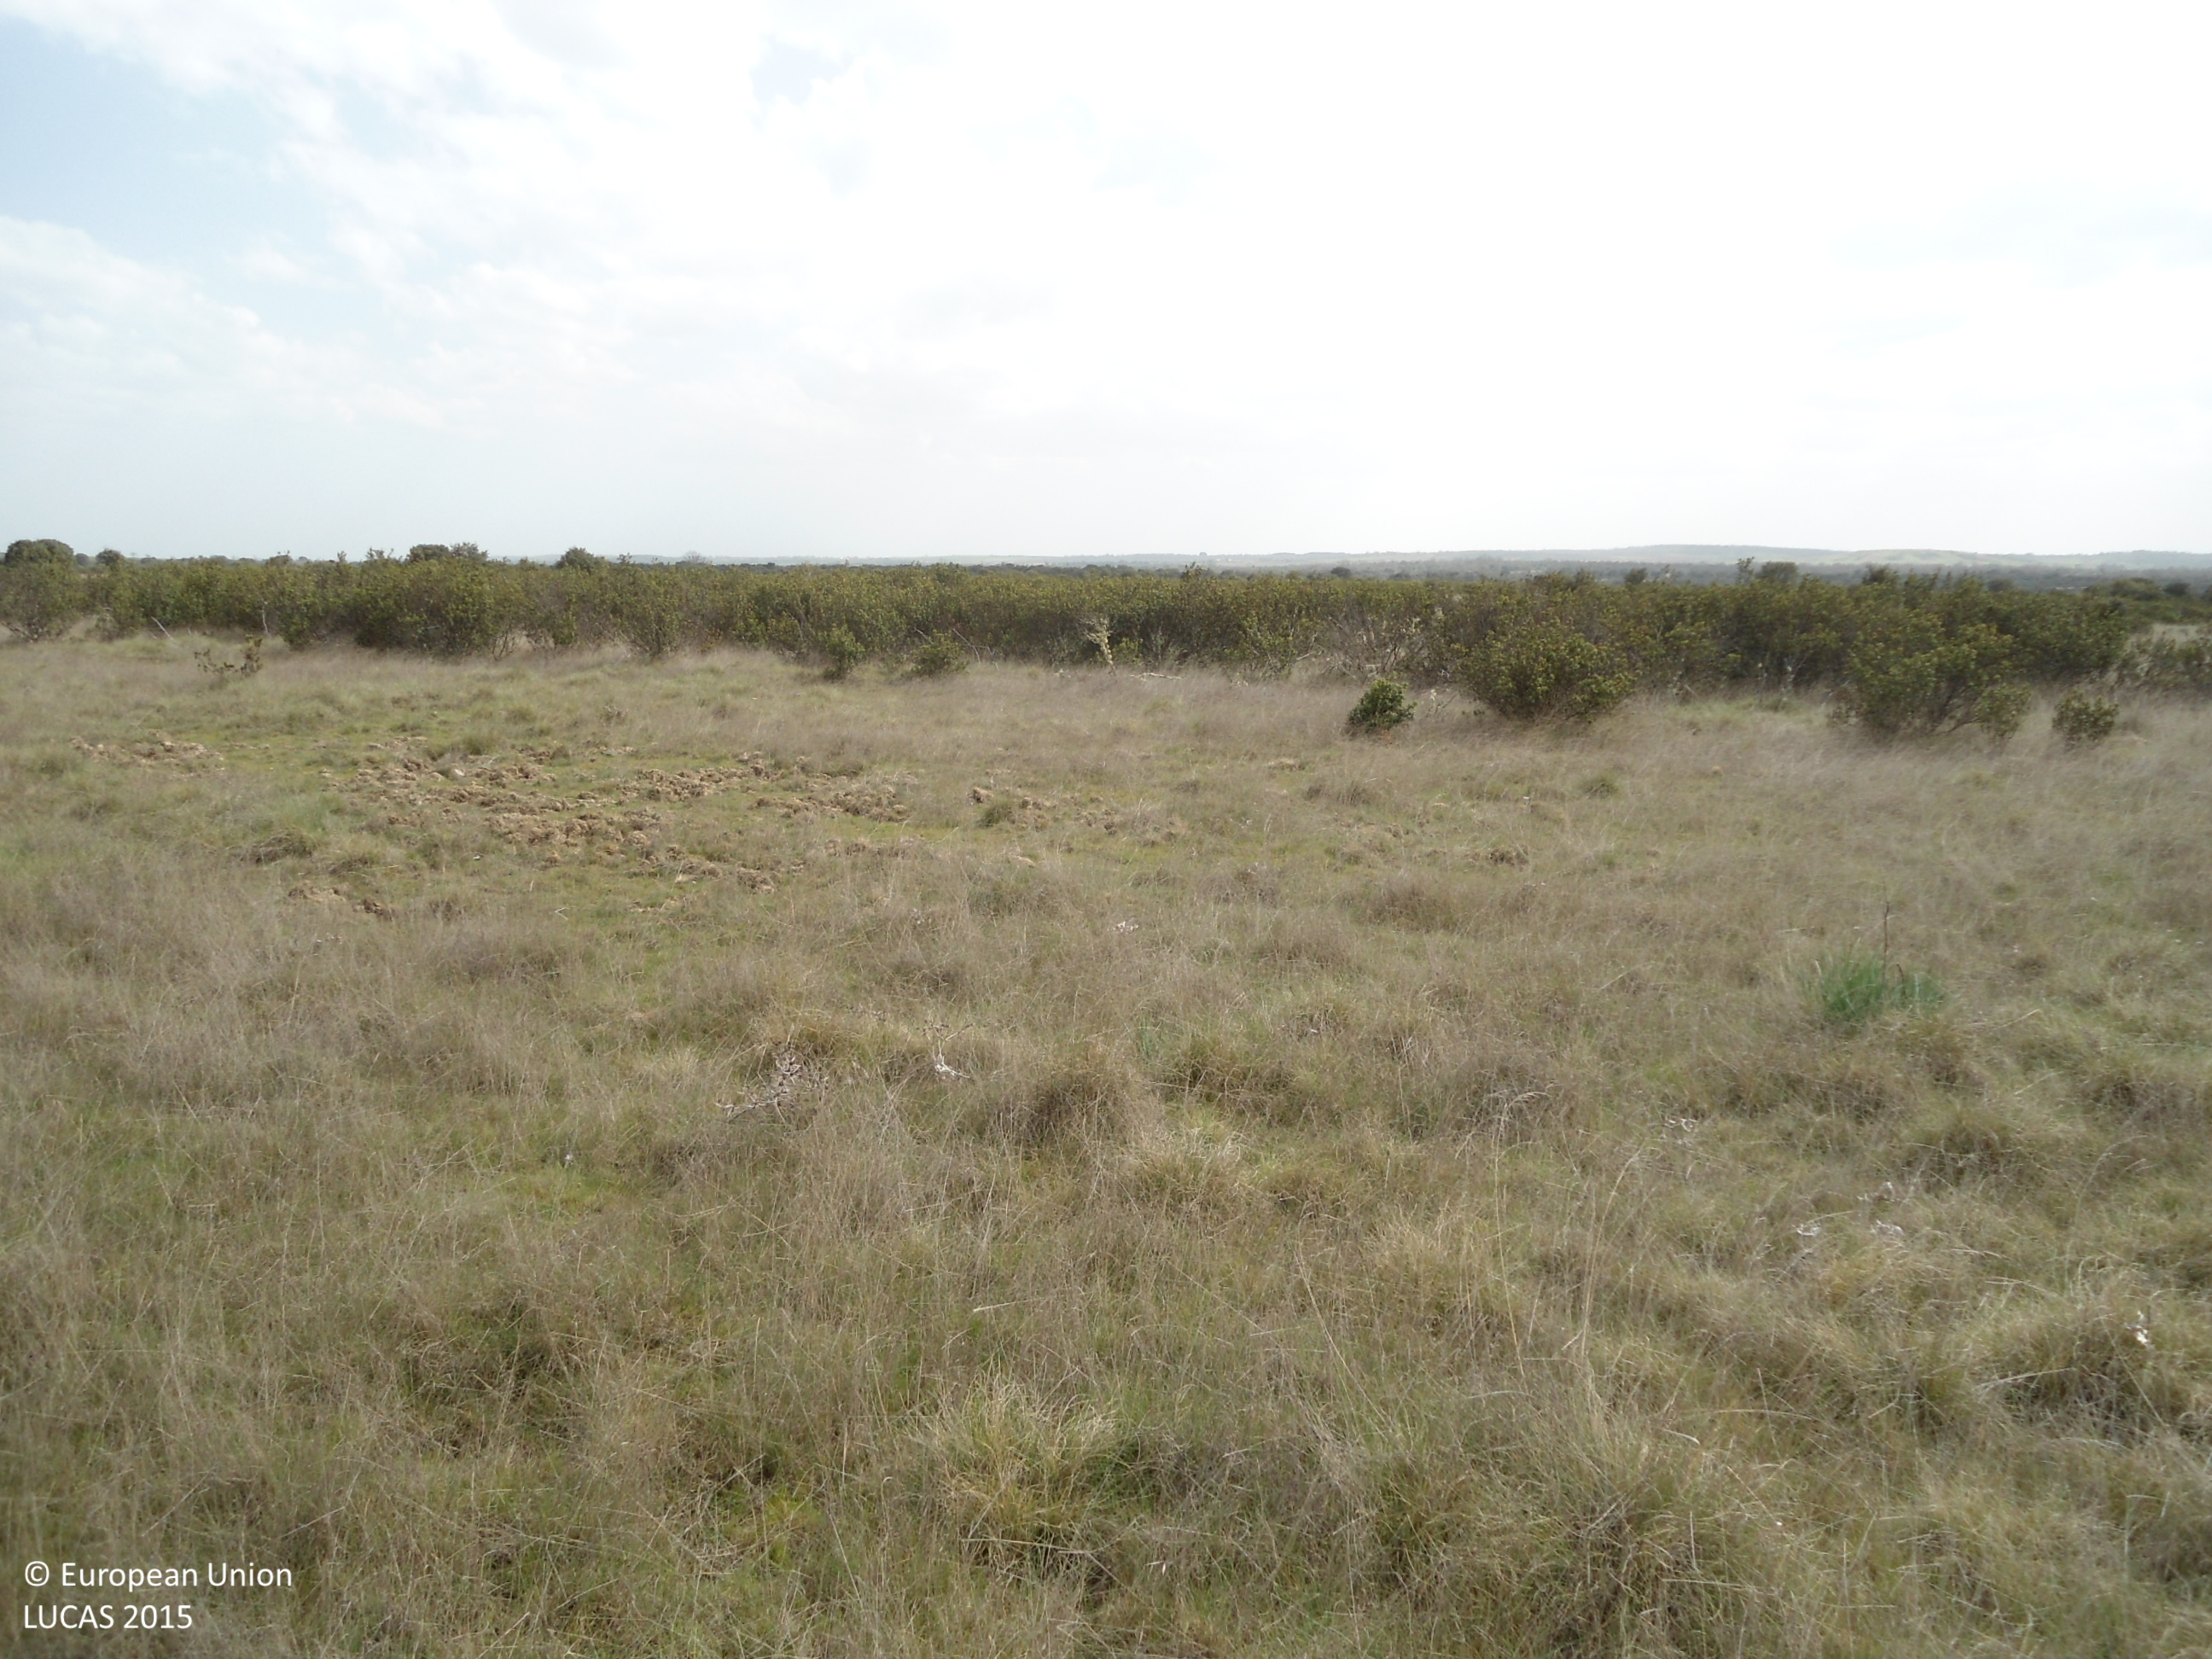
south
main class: Grassland
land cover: Grassland with sparse tree/shrub cover
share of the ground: > 75 %
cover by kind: herbaceous plants 90 %, broadleaved forest trees 5 %, shrubs 5 %
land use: Agriculture (excluding fallow land and kitchen gardens)
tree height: < 5 m
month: April
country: ES
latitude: 41.8166
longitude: -6.3187
